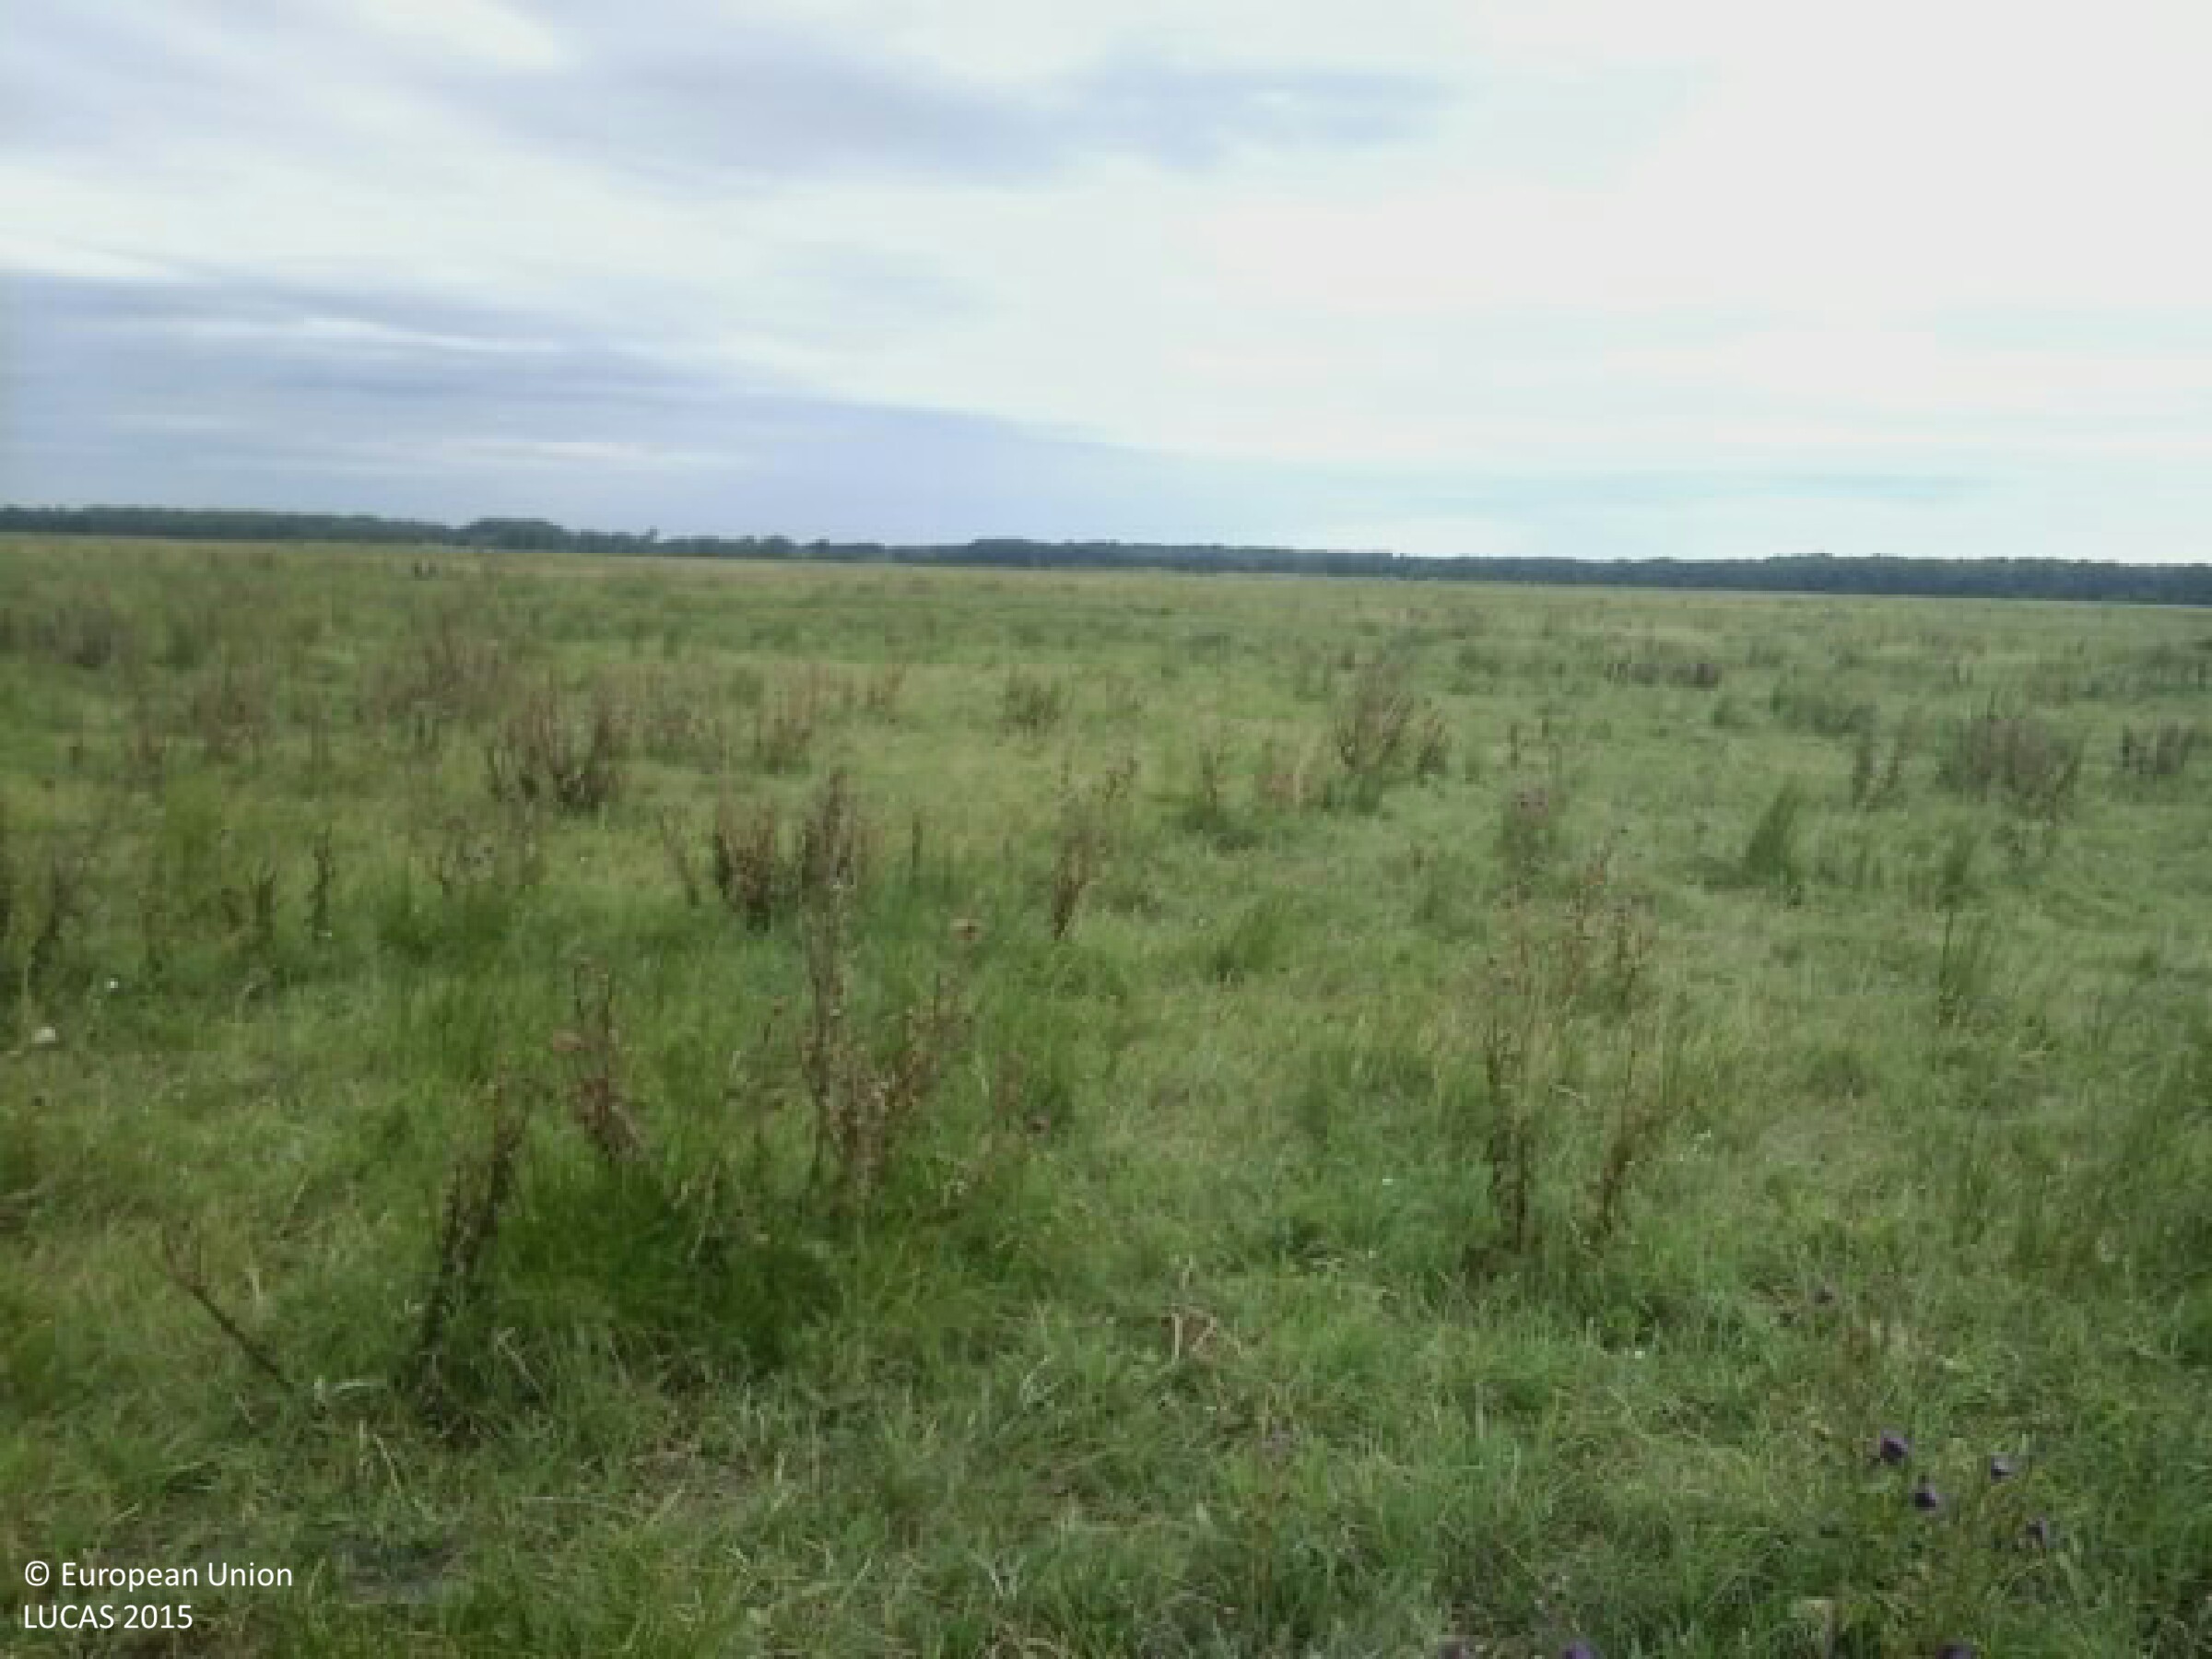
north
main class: Grassland
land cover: Grassland without tree/shrub cover
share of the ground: > 75 %
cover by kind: herbaceous plants 100 %
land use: Agriculture (excluding fallow land and kitchen gardens)
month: June
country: HU
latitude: 46.6798
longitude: 19.6018
